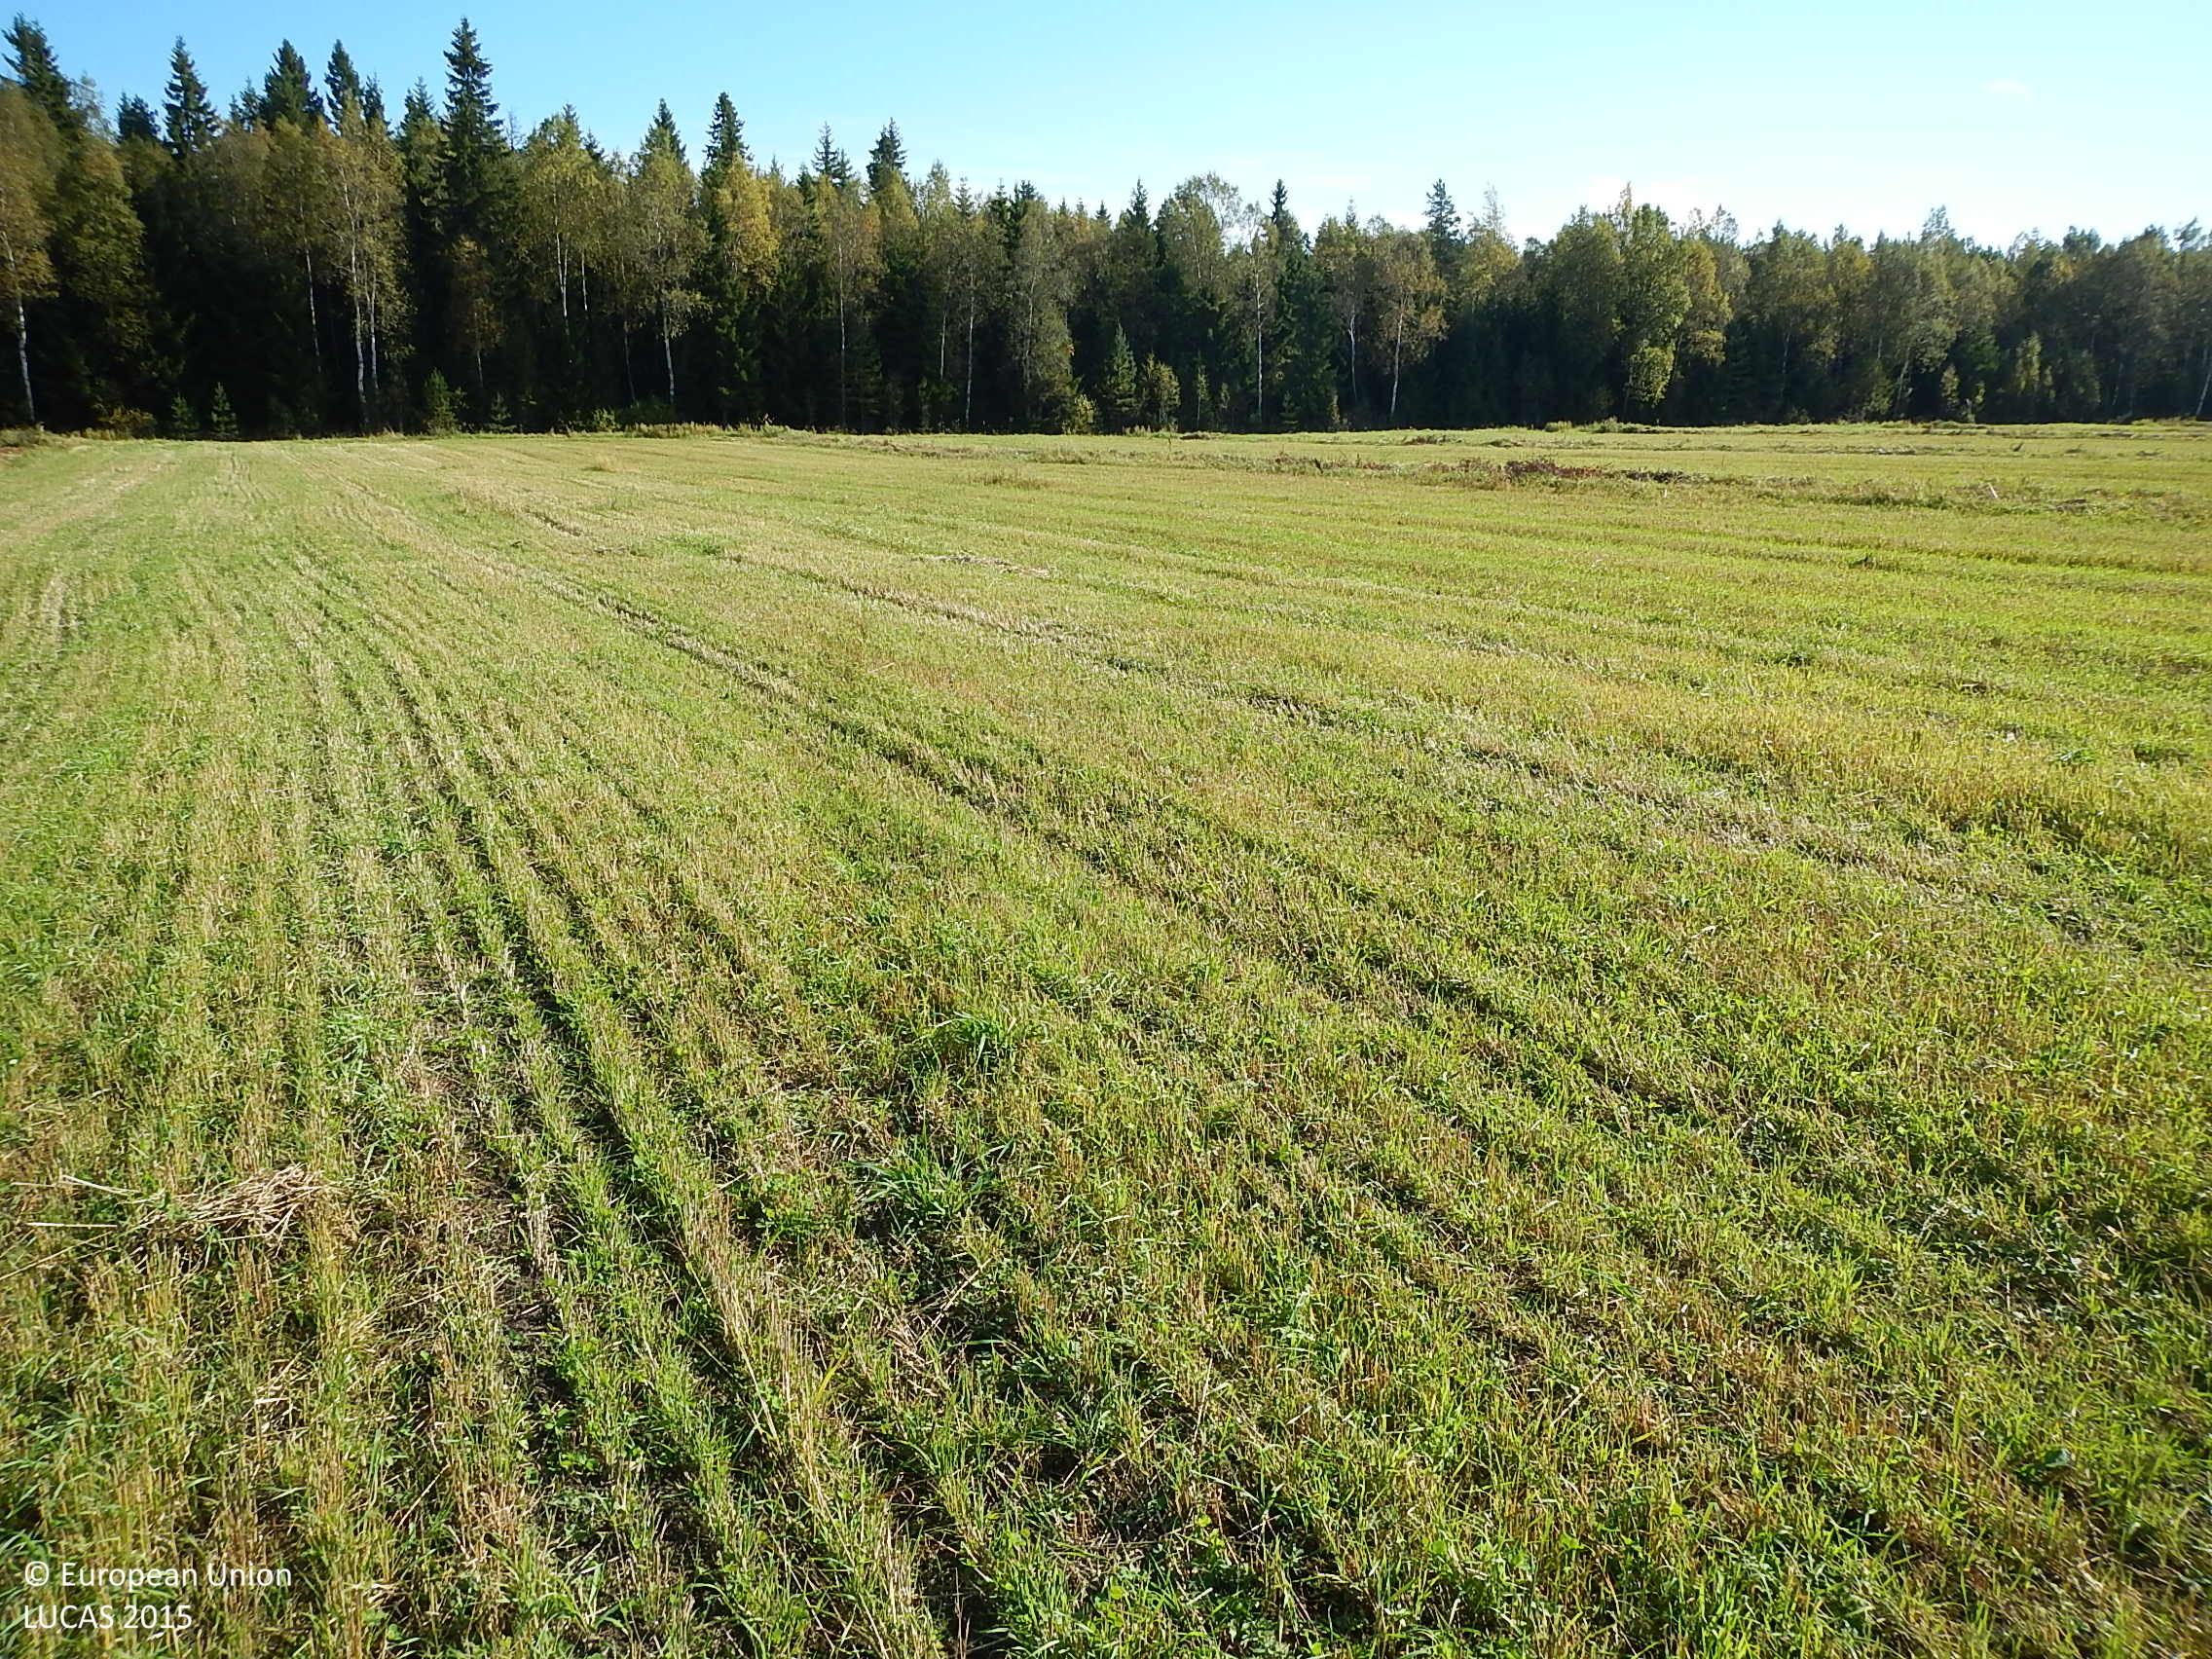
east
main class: Cropland
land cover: Oats
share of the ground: > 75 %
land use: Agriculture (excluding fallow land and kitchen gardens)
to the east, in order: Oats; Grass margins; Ditches and canals; Grass margins; Oats; Grass margins; Ditches and canals; Grass margins; Oats; Grass margins; Ditches and canals; Spruce dominated mixed woodland; Ditches and canals; Spruce dominated coniferous woodland; Ditches and canals; Spruce dominated coniferous woodland; Other mixed woodland
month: September
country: FI
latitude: 61.9864
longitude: 21.5175
